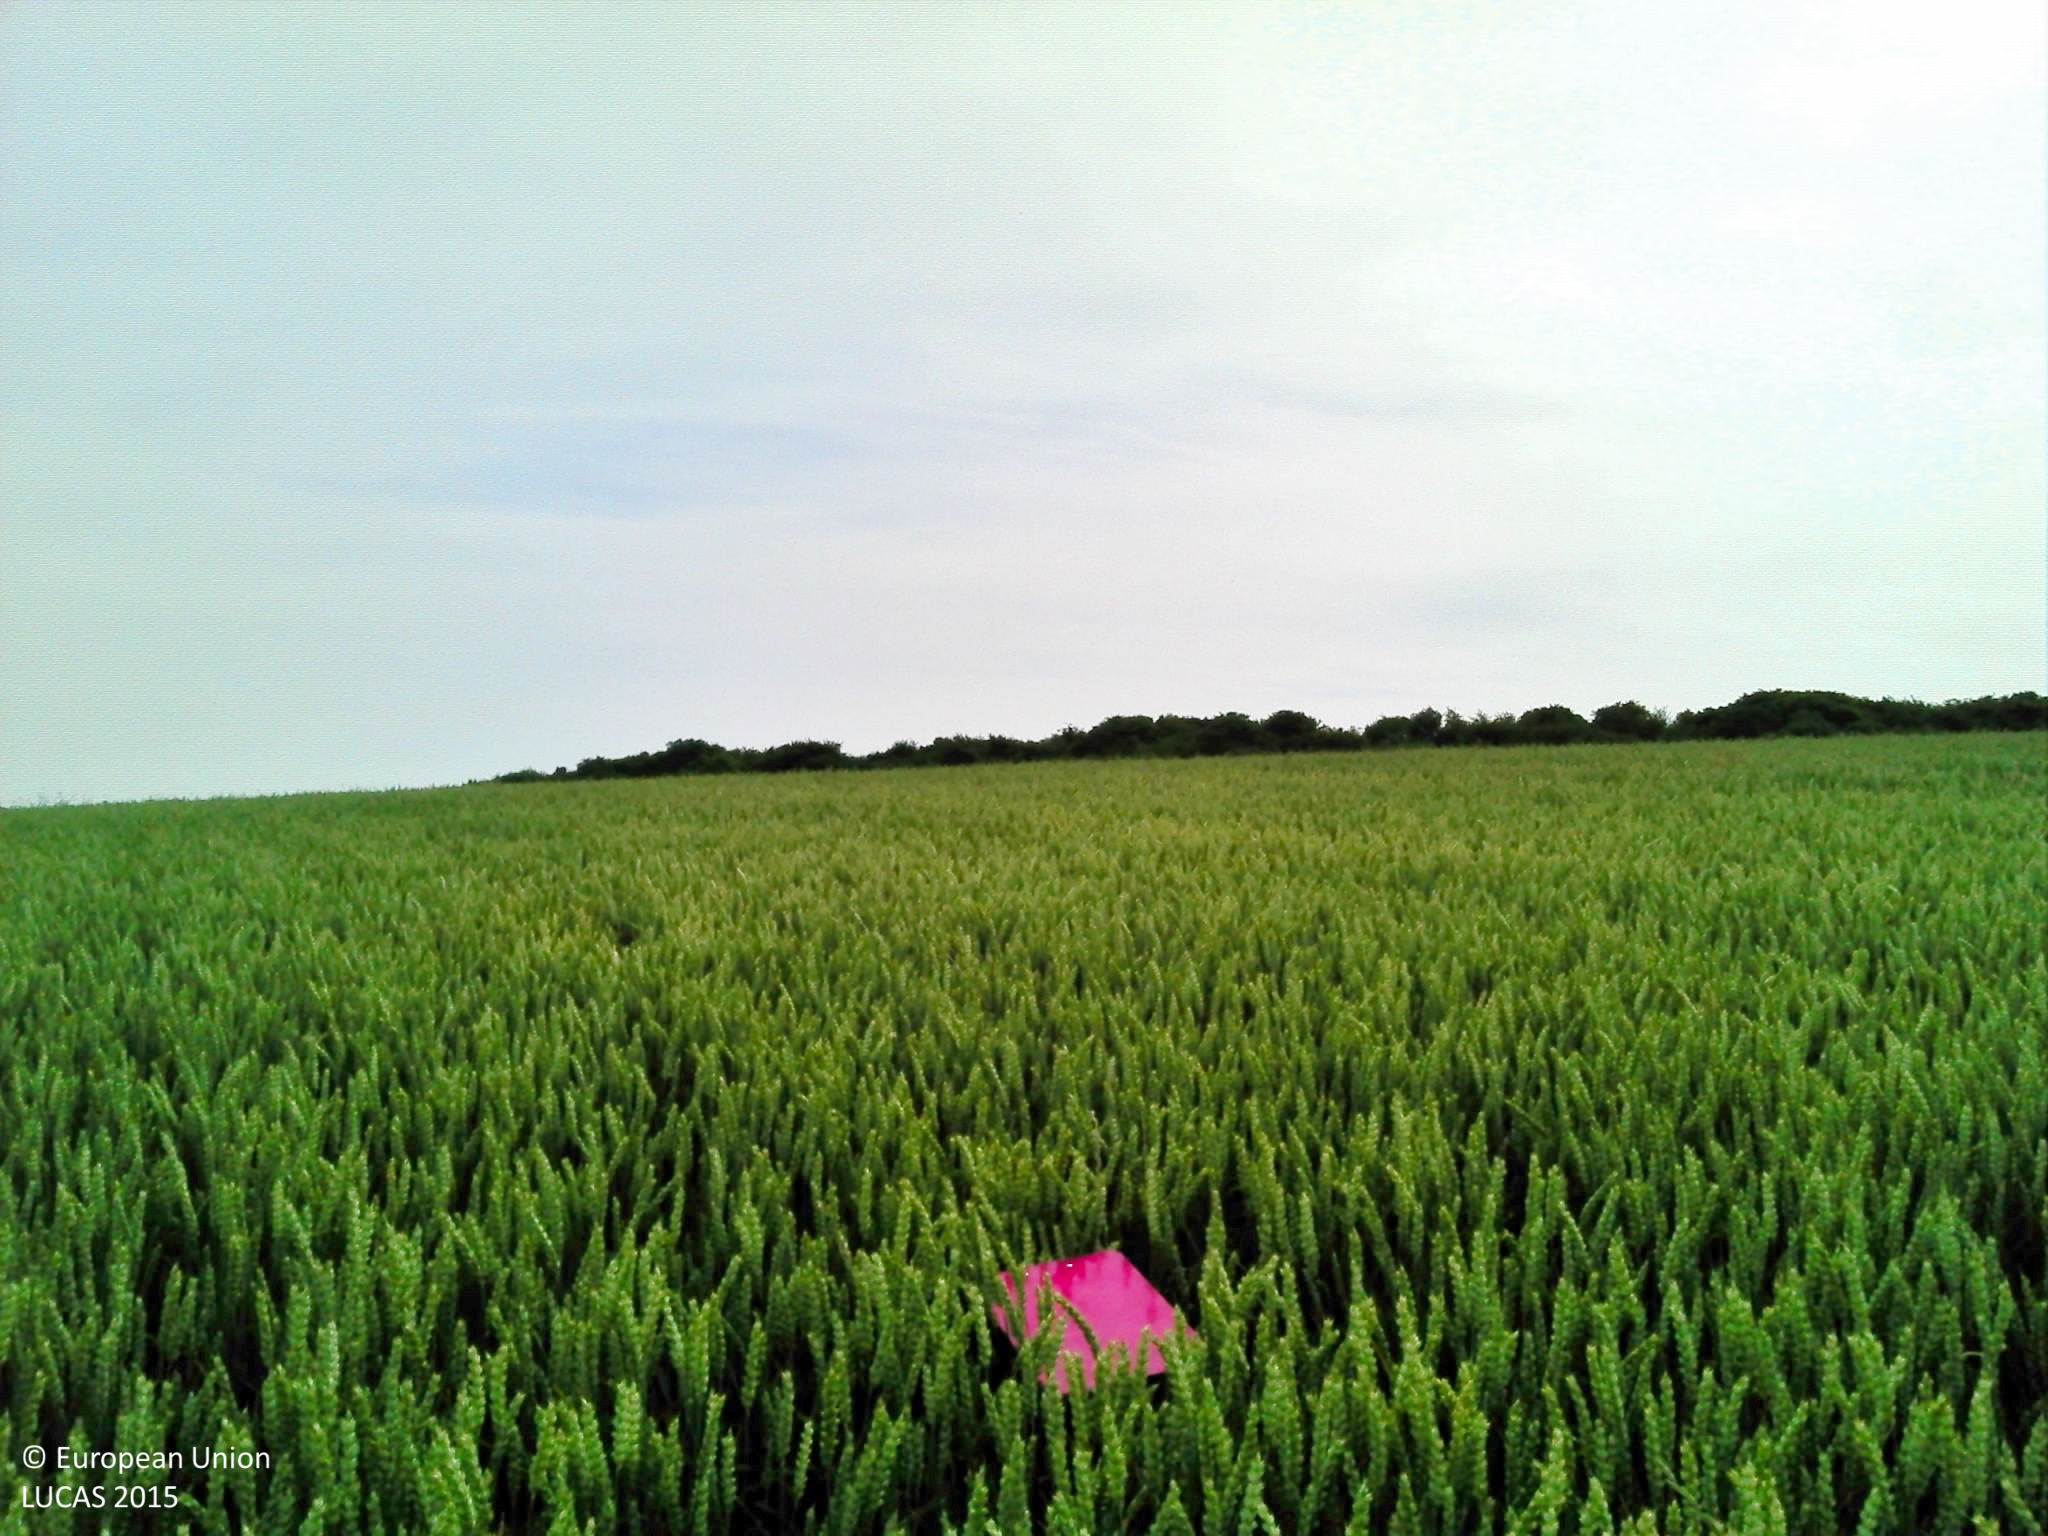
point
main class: Cropland
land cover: Common wheat
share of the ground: > 75 %
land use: Agriculture (excluding fallow land and kitchen gardens)
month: June
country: FR
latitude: 49.6403
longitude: 2.3848
